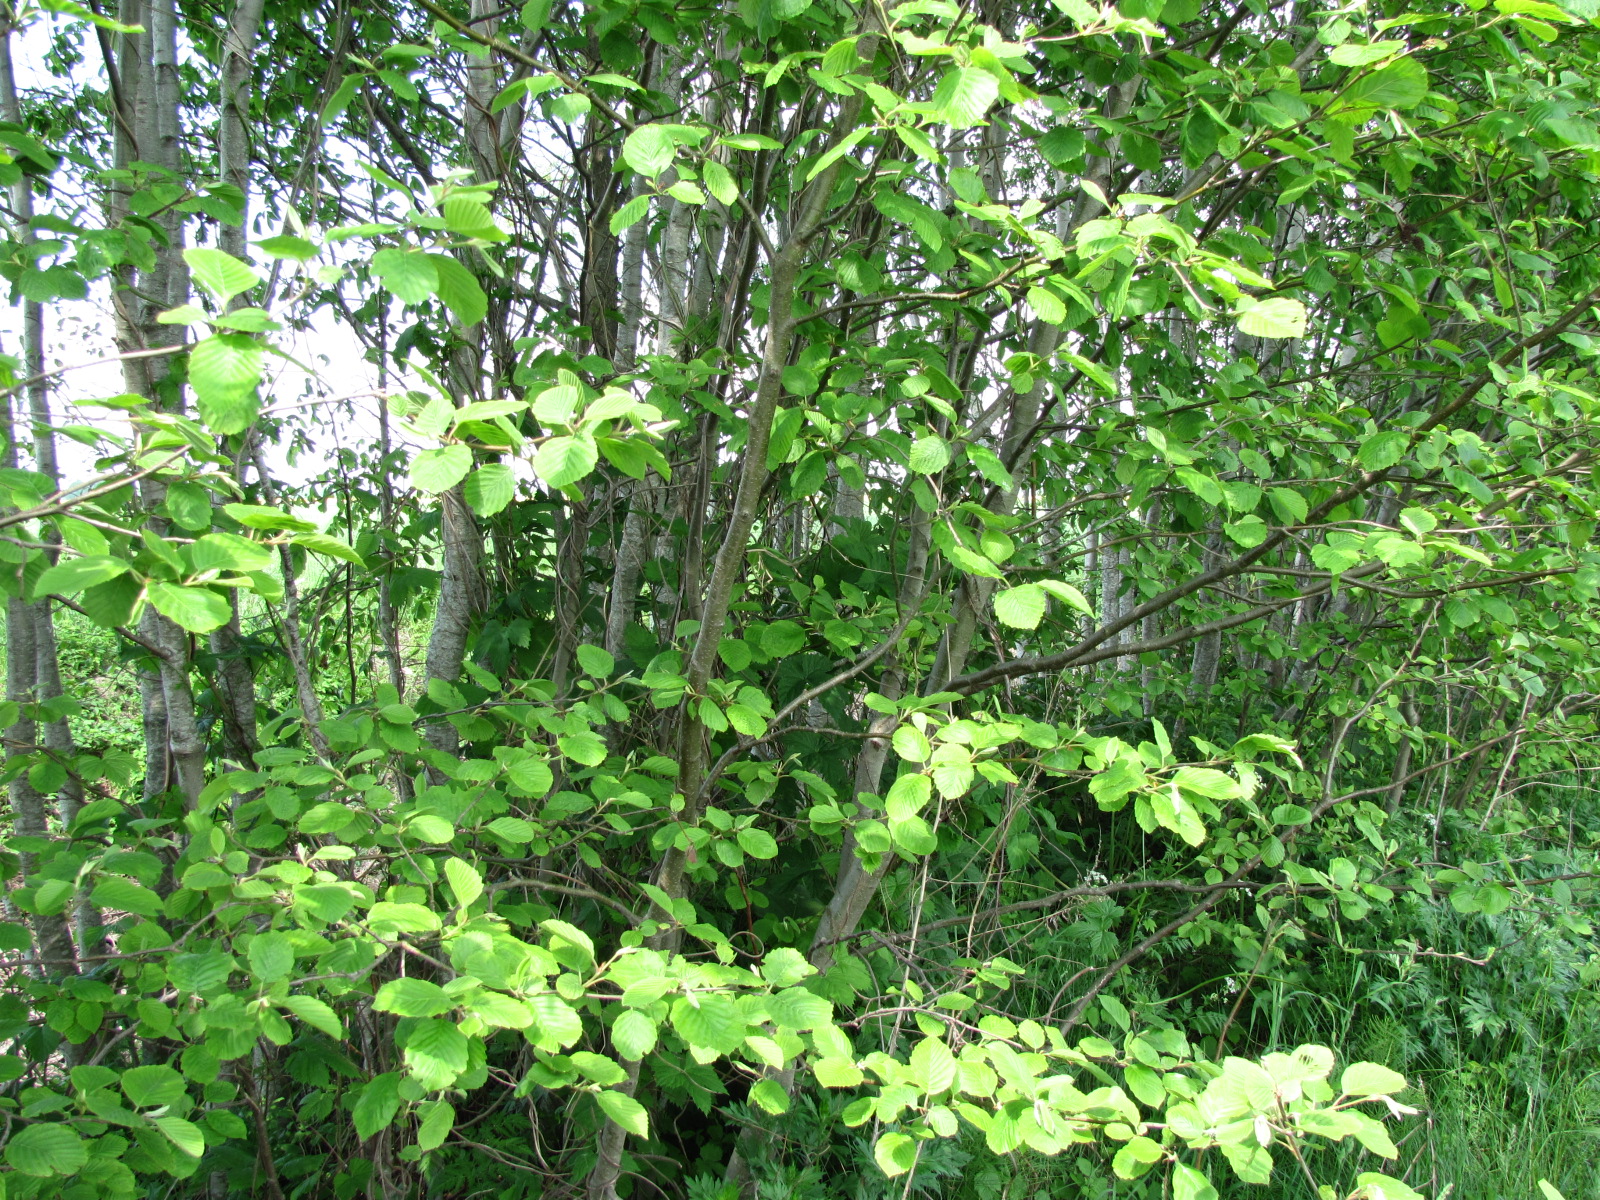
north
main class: Woodland
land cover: Broadleaved woodland
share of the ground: > 75 %
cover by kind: broadleaved forest trees 100 %
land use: Agriculture (excluding fallow land and kitchen gardens)
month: May
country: LV
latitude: 56.5459
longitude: 24.0246
